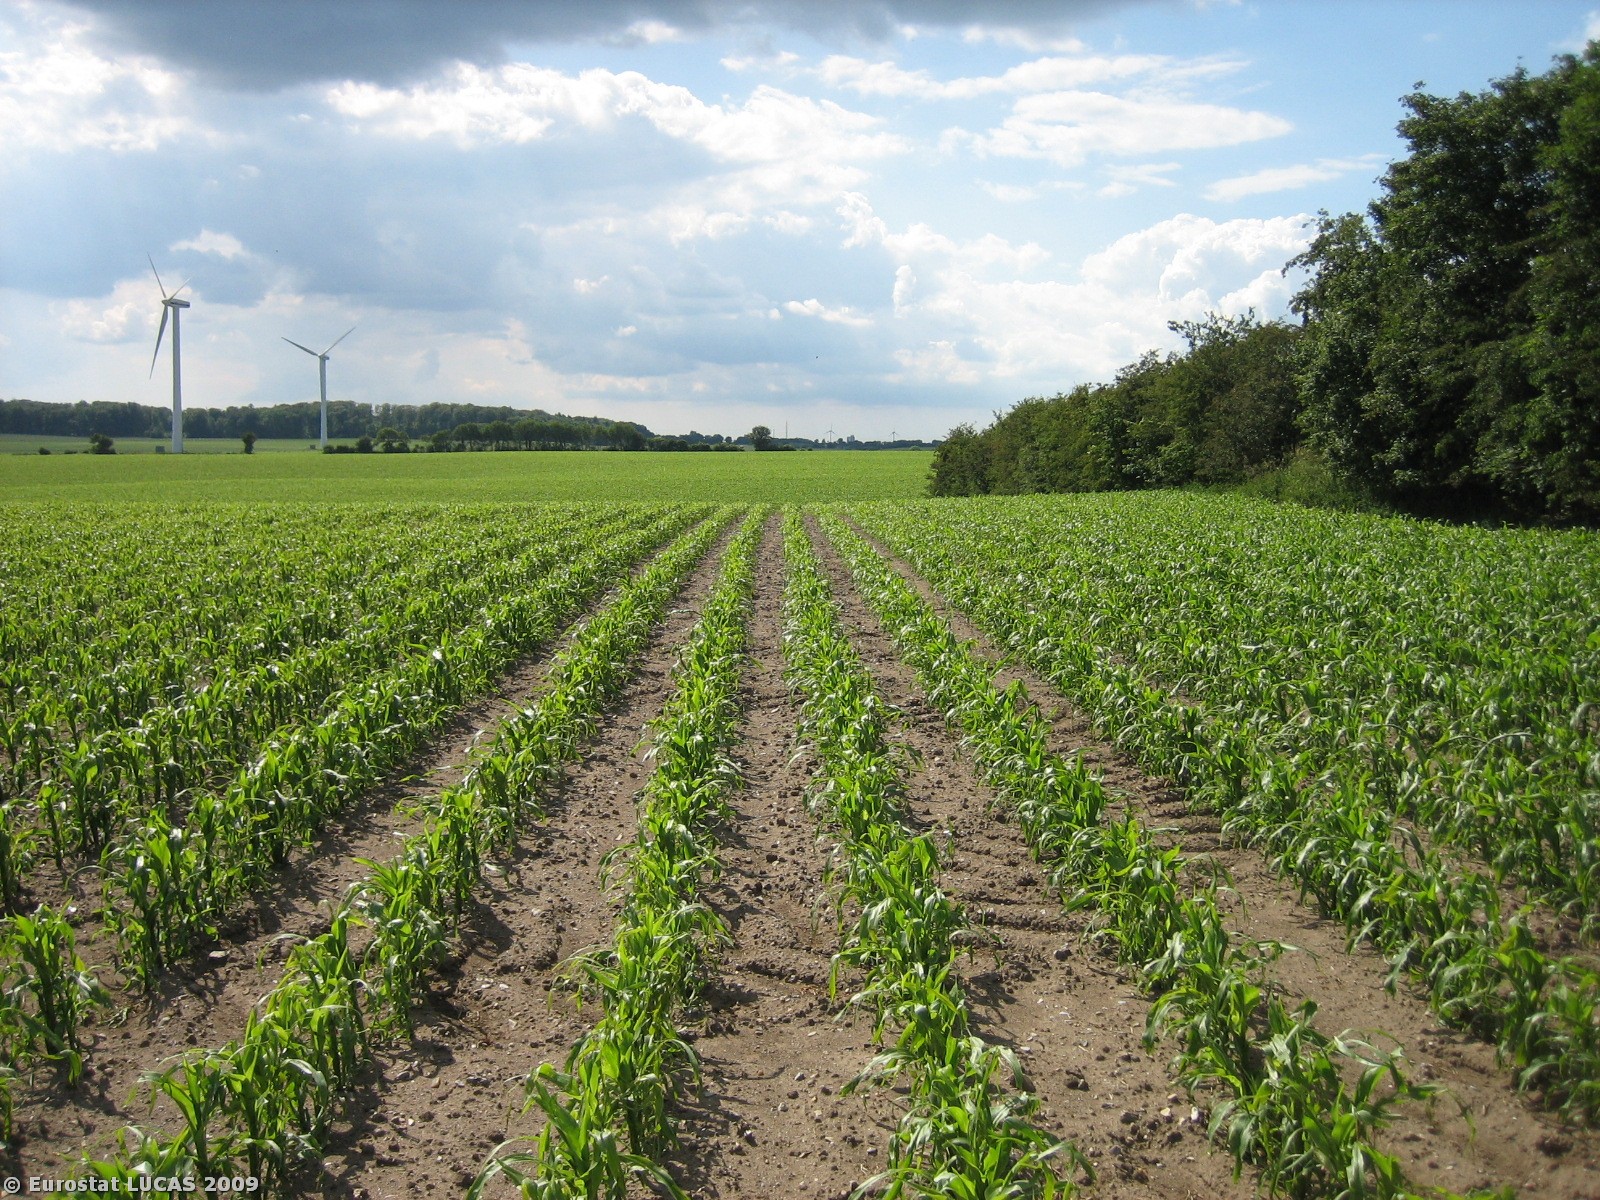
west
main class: Cropland
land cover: Maize
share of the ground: 10 - 25 %
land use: Agriculture (excluding fallow land and kitchen gardens)
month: June
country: DK
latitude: 55.4667
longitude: 9.2889
